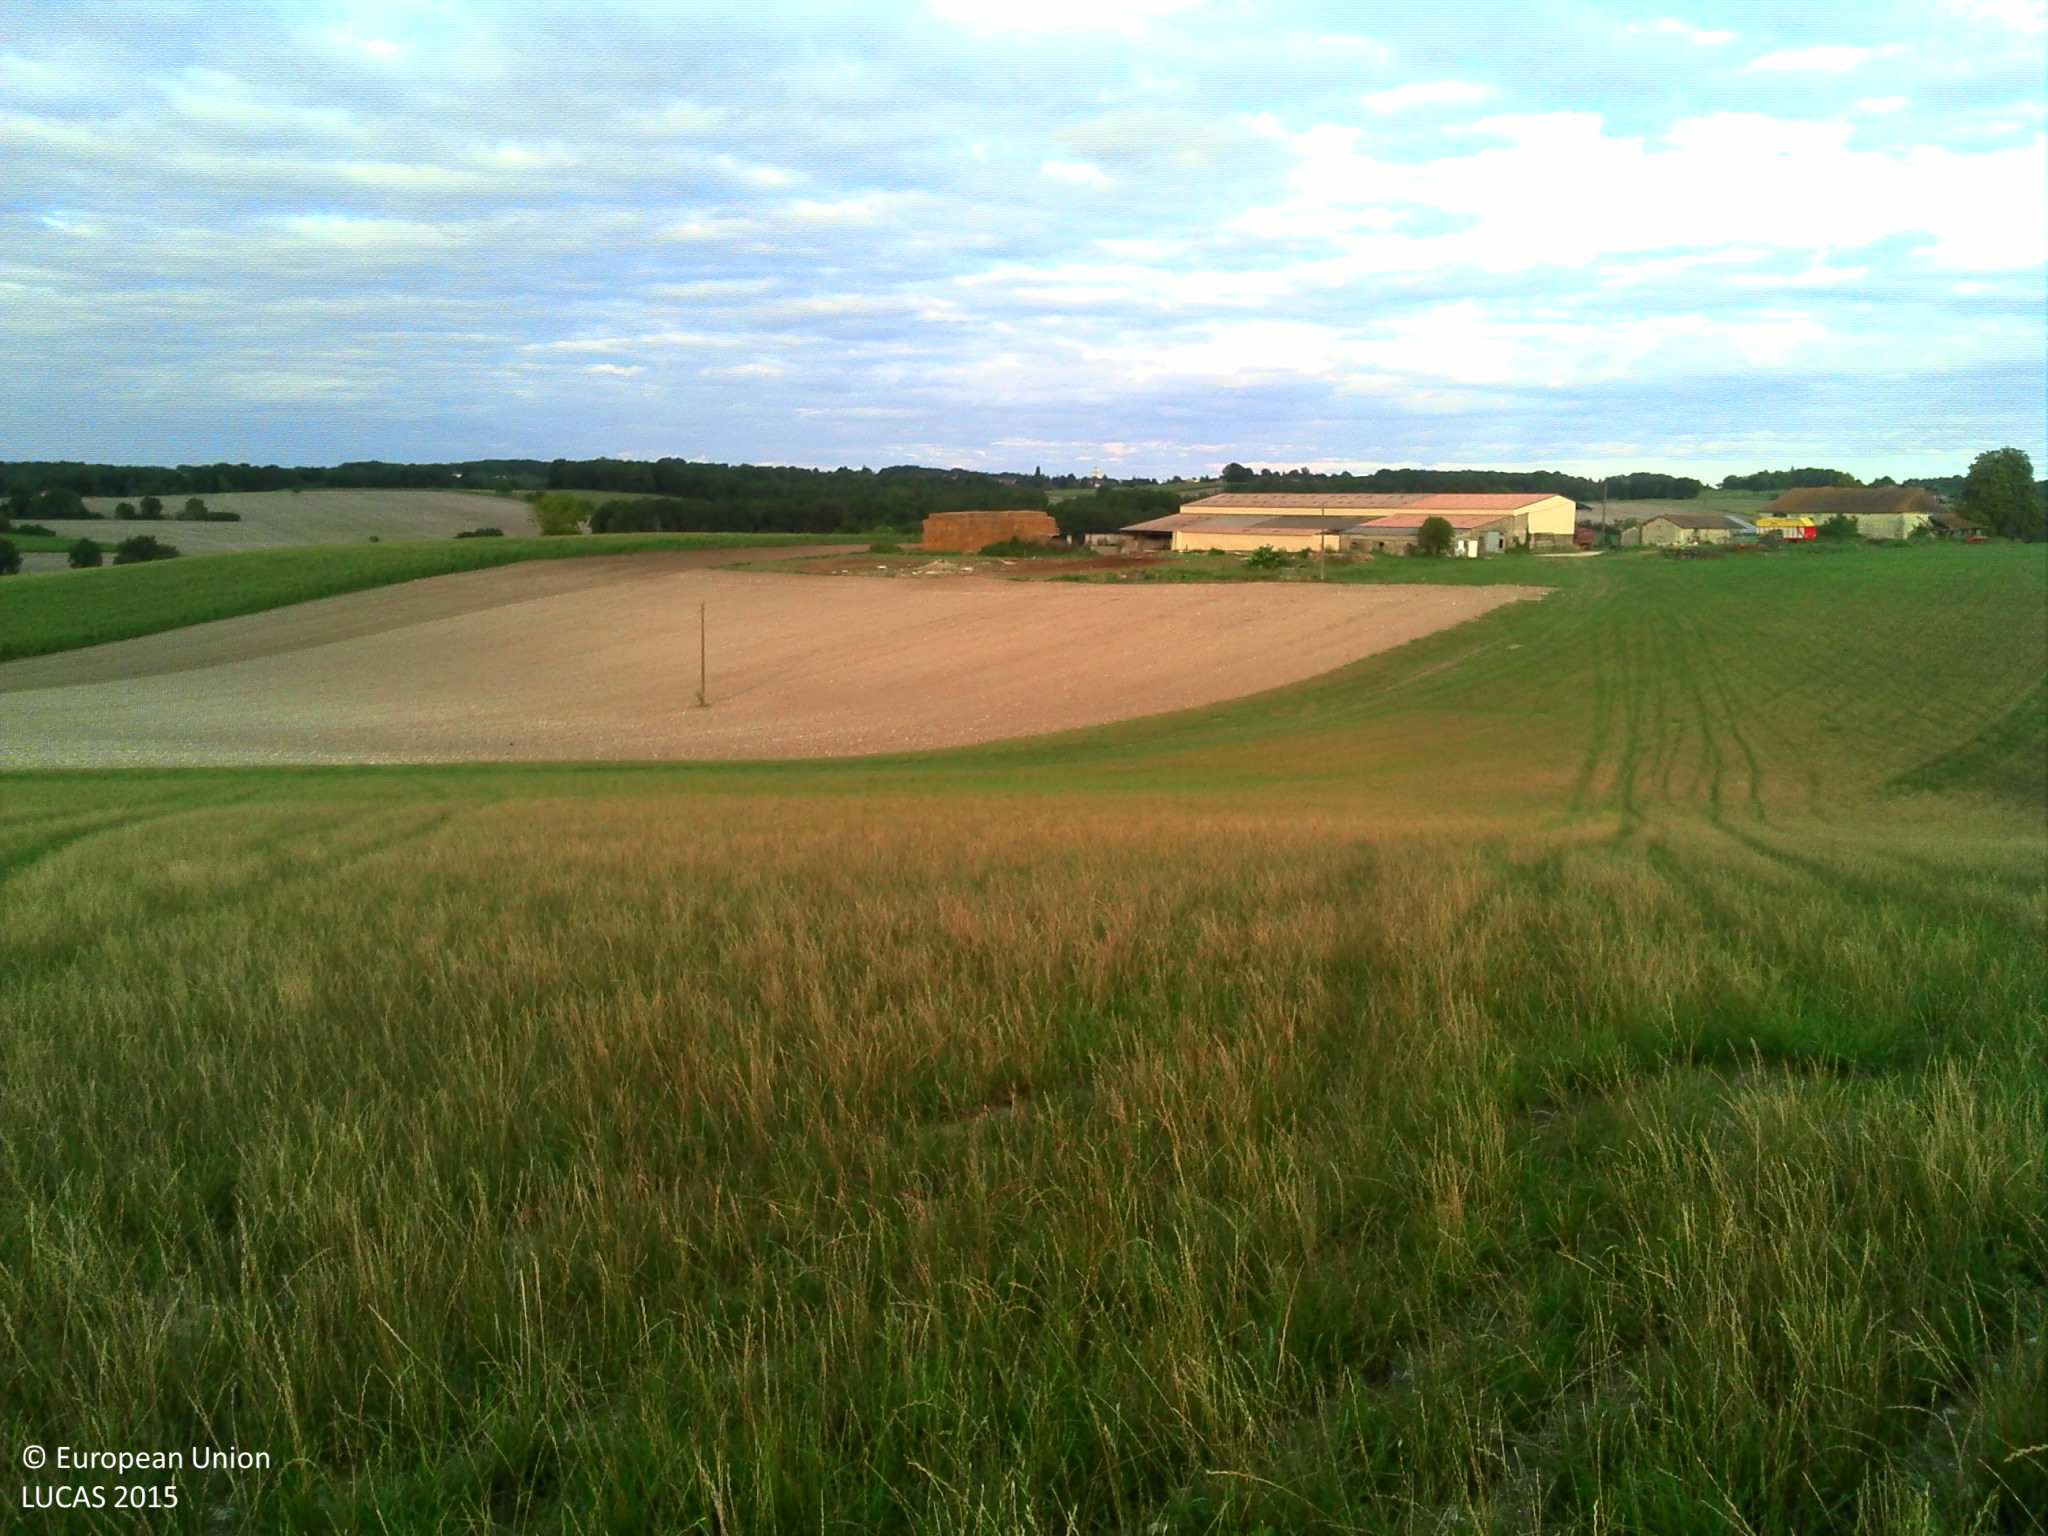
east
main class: Cropland
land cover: Temporary grasslands
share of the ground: > 75 %
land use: Agriculture (excluding fallow land and kitchen gardens)
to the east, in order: Temporary grasslands; Other bare soil; Electric lines; Other bare soil; Fences; Spontaneously vegetated surfaces
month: August
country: FR
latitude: 45.2226
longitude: 0.5263
